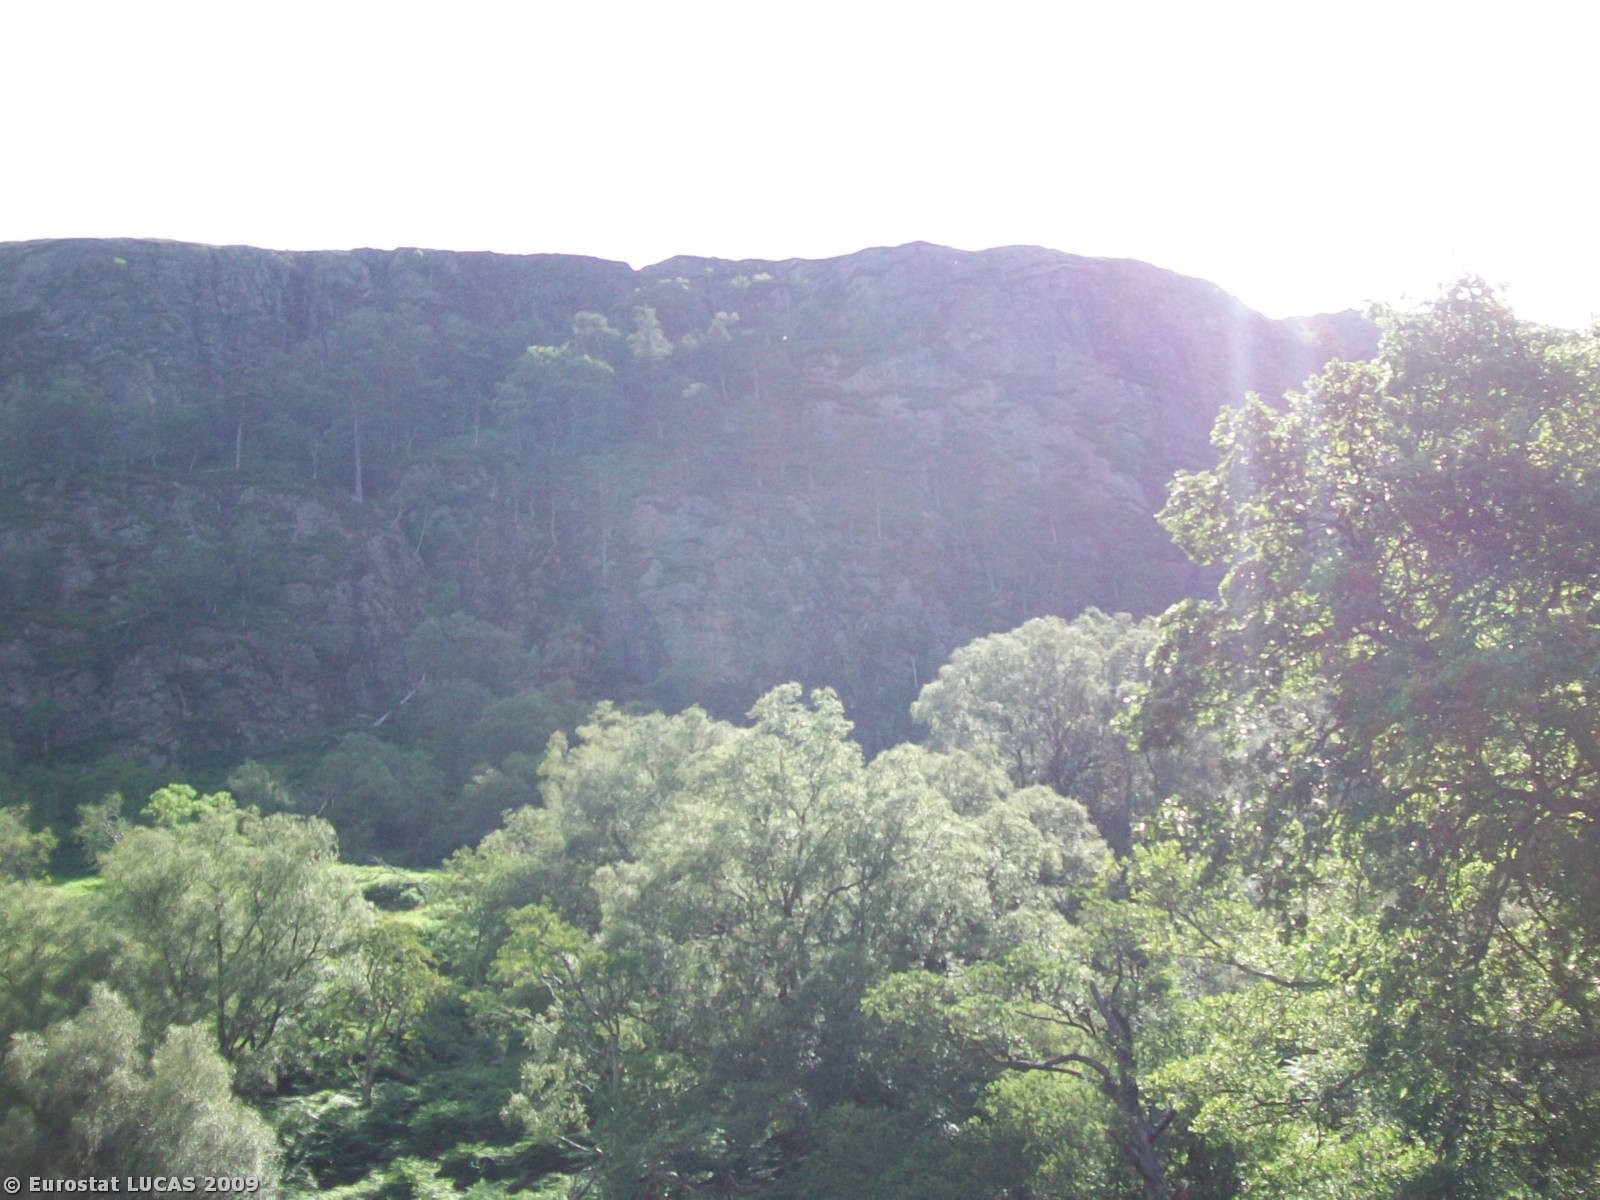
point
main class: Grassland
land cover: Grassland with sparse tree/shrub cover
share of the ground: > 75 %
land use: Forestry
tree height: > 5 m
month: July
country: GB
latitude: 57.8275
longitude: -5.1753
